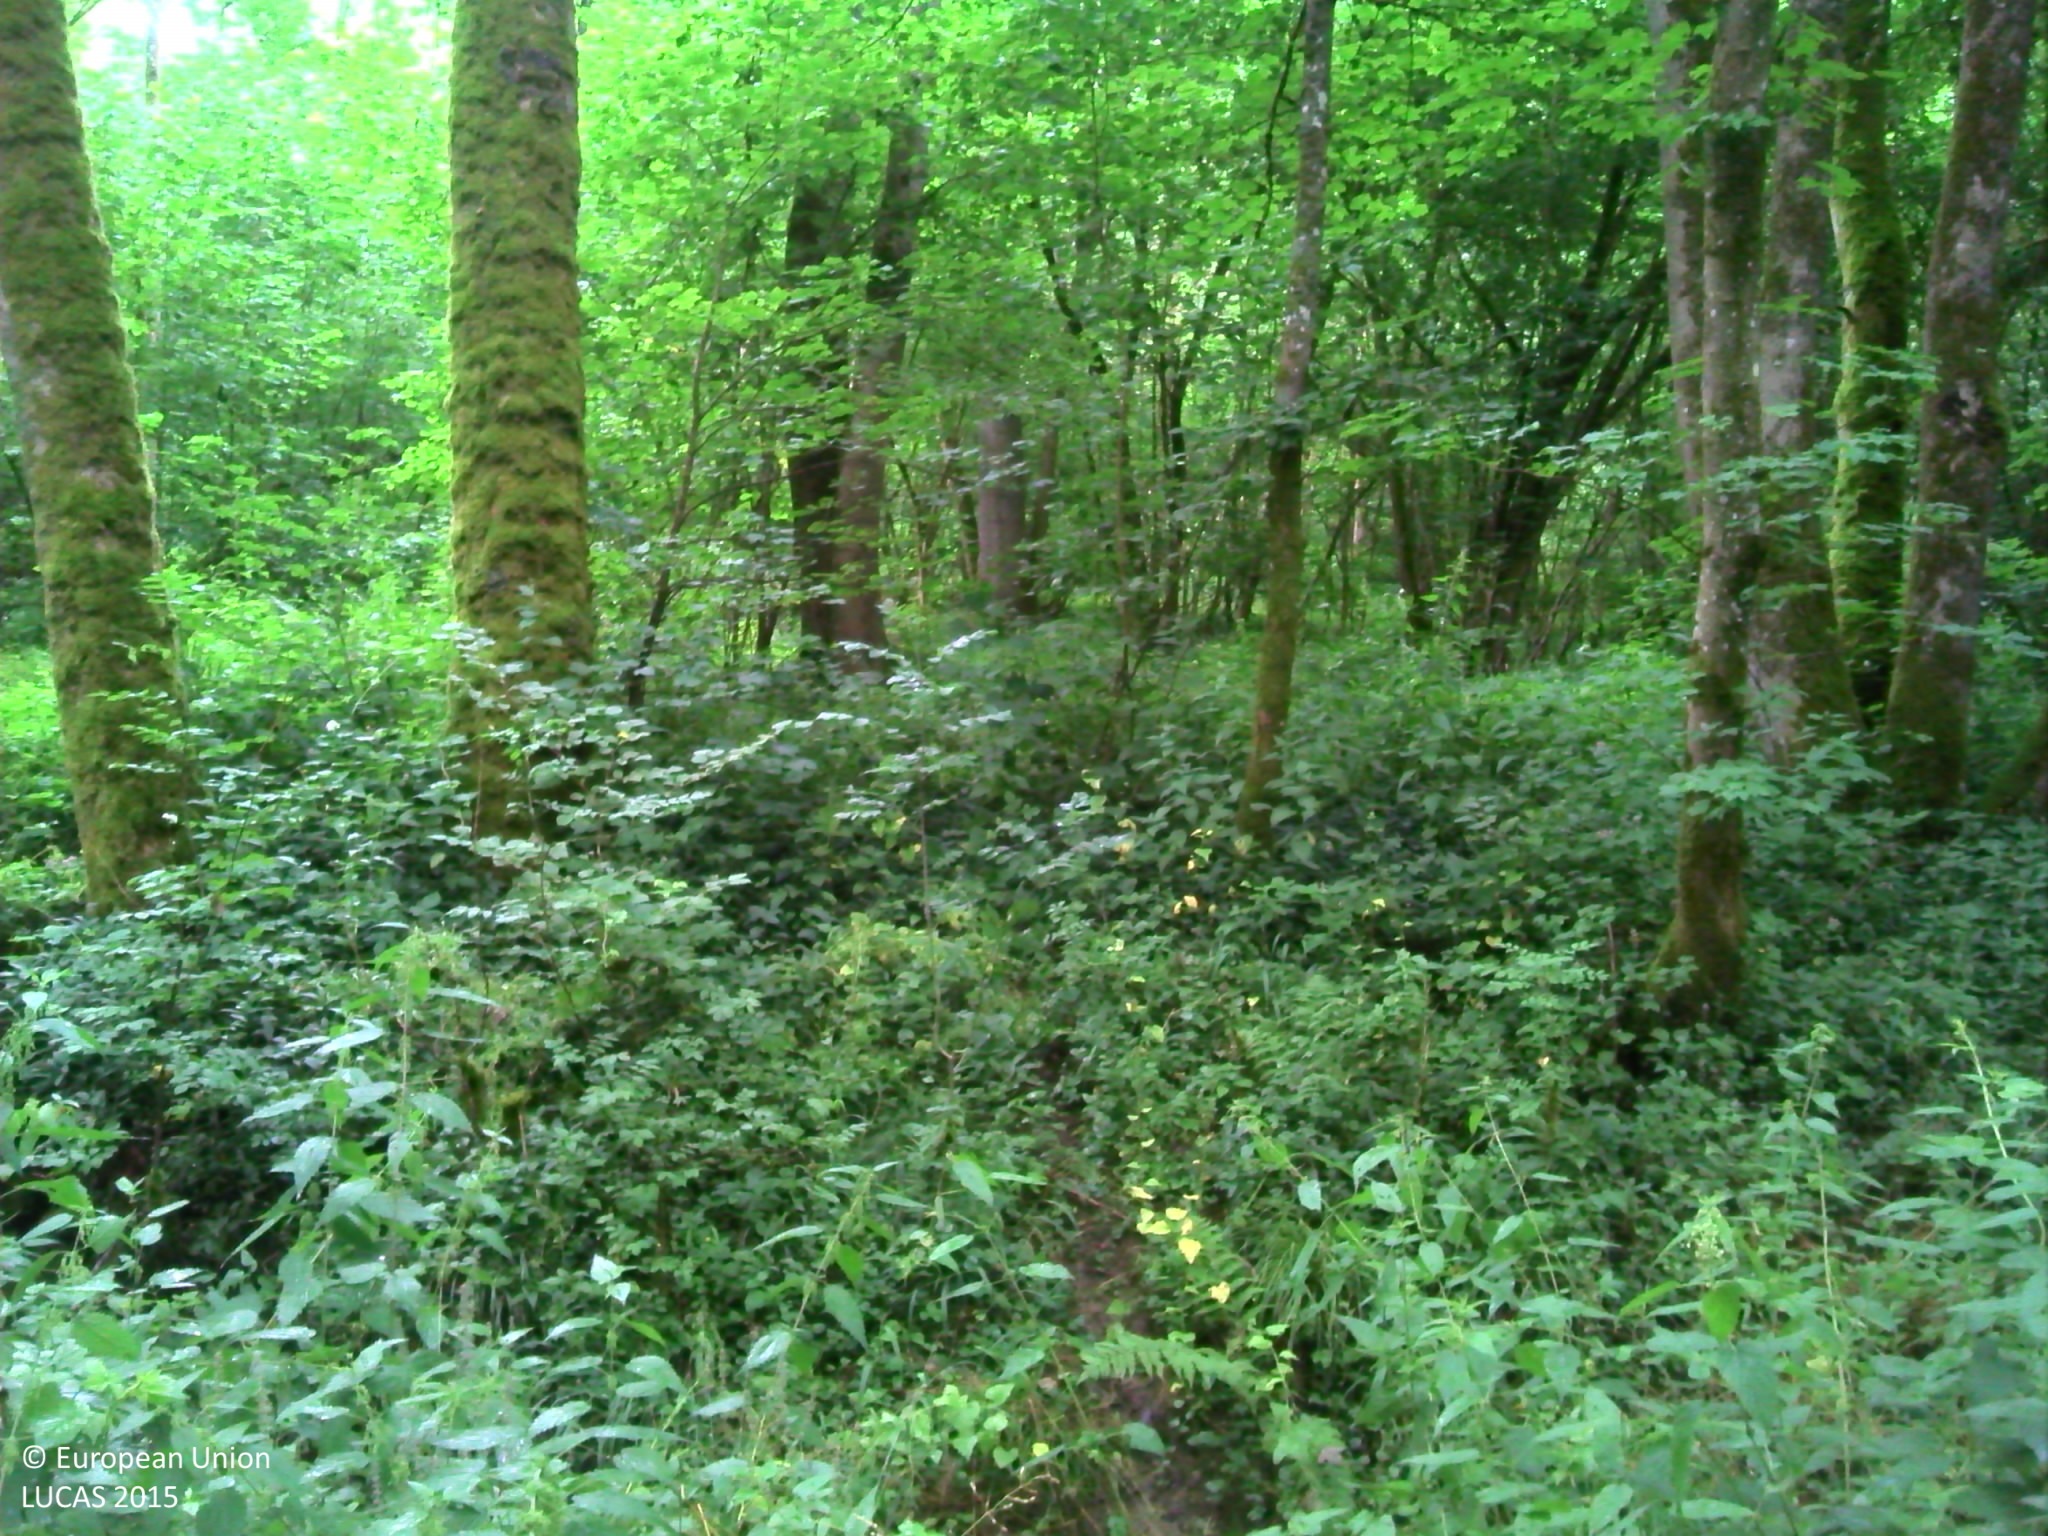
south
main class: Woodland
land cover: Broadleaved woodland
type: mesophytic deciduous forest
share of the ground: > 75 %
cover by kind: broadleaved forest trees 100 %
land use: Forestry
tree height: > 5 m
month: July
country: BE
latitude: 50.2032
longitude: 4.6584
